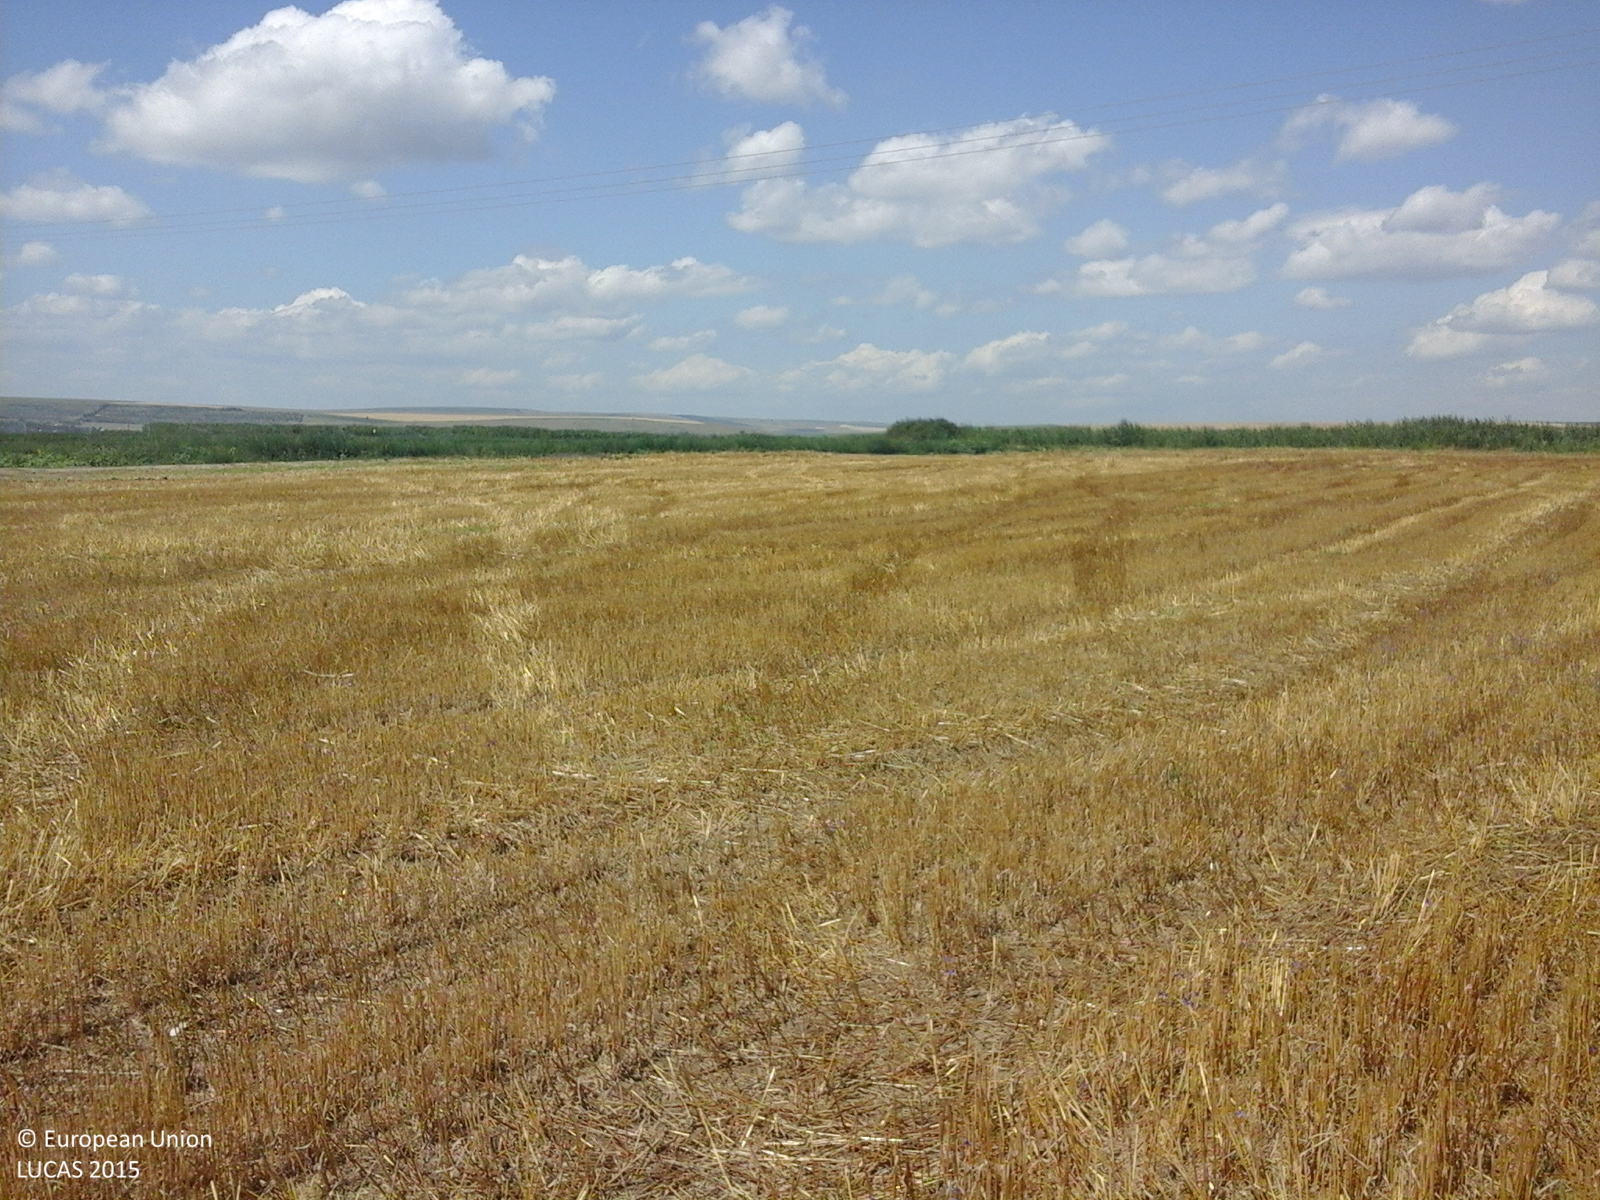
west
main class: Cropland
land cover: Common wheat
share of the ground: 50 - 75 %
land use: Agriculture (excluding fallow land and kitchen gardens)
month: July
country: RO
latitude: 46.3964
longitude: 28.1968
